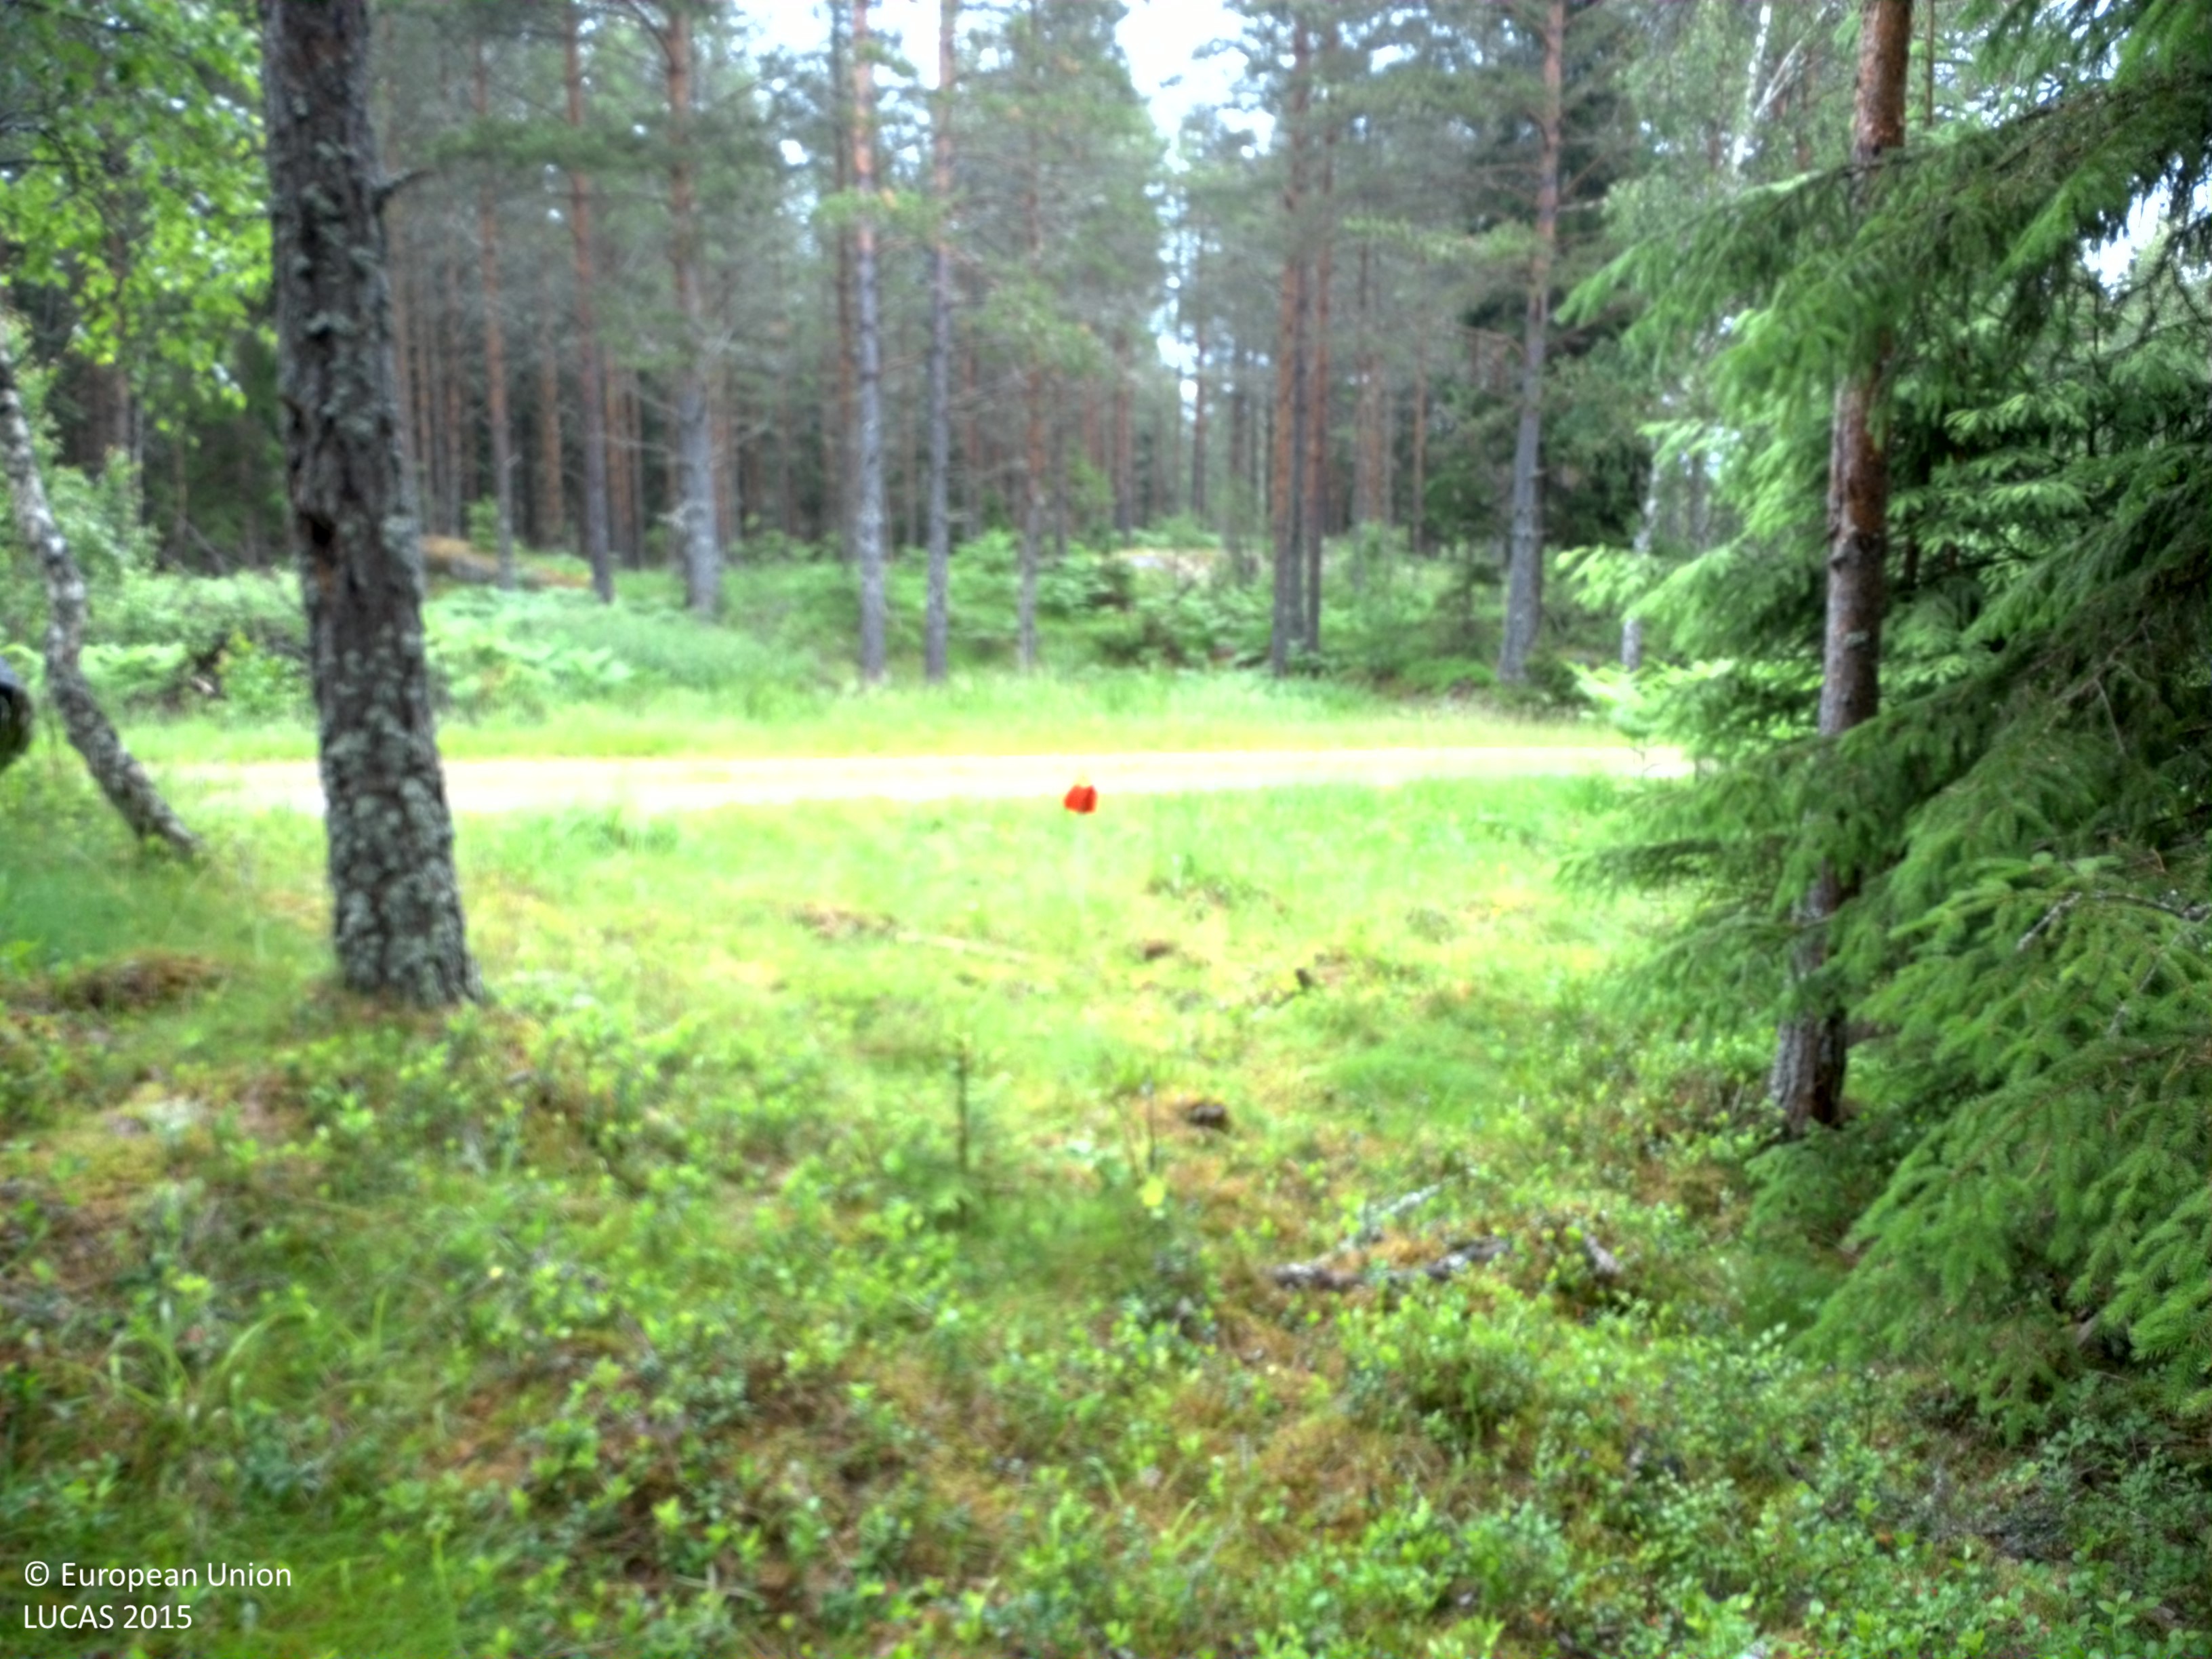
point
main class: Woodland
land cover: Pine dominated mixed woodland
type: boreal forest
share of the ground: 25 - 50 %
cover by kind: herbaceous plants 45 %, coniferous forest trees 30 %, broadleaved forest trees 15 %, lichens and mosses 10 %
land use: Forestry
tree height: > 5 m
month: June
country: SE
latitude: 58.6677
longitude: 15.4592
